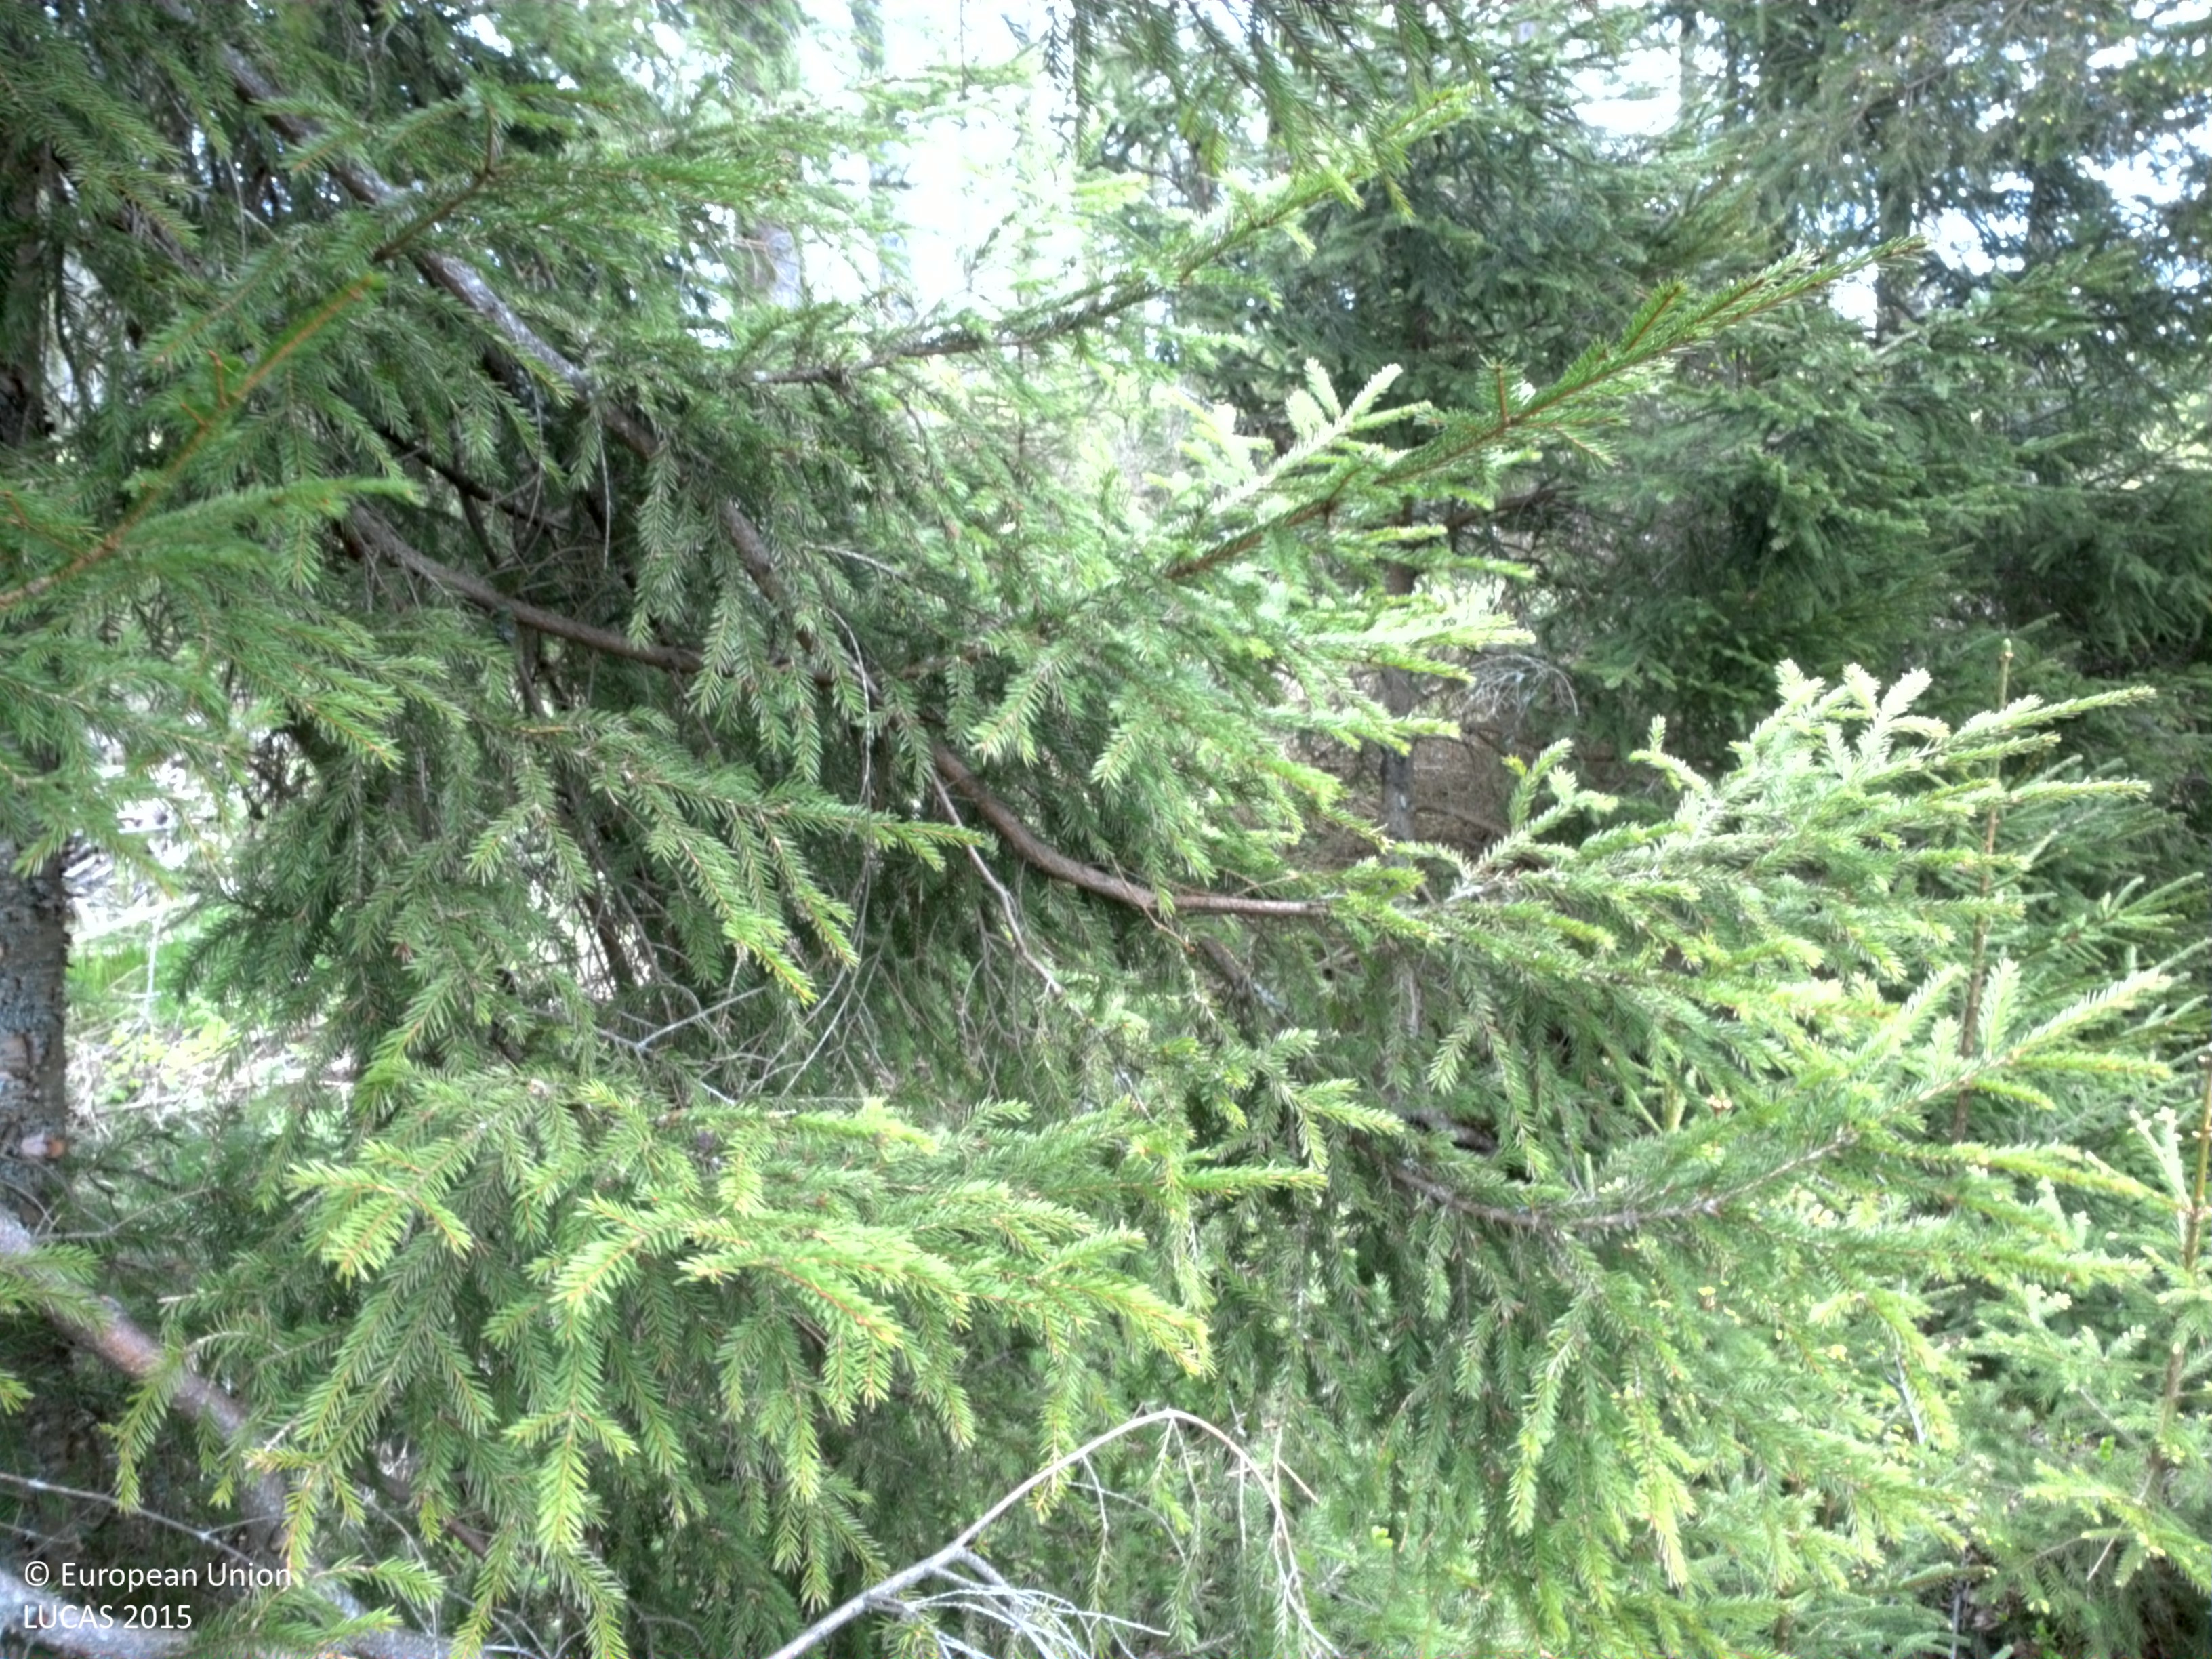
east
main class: Woodland
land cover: Spruce dominated mixed woodland
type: boreal forest
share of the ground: 25 - 50 %
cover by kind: coniferous forest trees 30 %, herbaceous plants 20 %, unconsolidated bare surface 15 %, broadleaved forest trees 10 %, shrubs 10 %, lichens and mosses 10 %, consolidated bare surface 5 %
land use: Forestry
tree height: > 5 m
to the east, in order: Spruce dominated mixed woodland; Ditches and canals; Spruce dominated mixed woodland; Tracks; Groves; Ditches and canals; Shrubland without tree cover; Spruce dominated mixed woodland
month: May
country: SE
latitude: 56.6563
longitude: 15.2672
